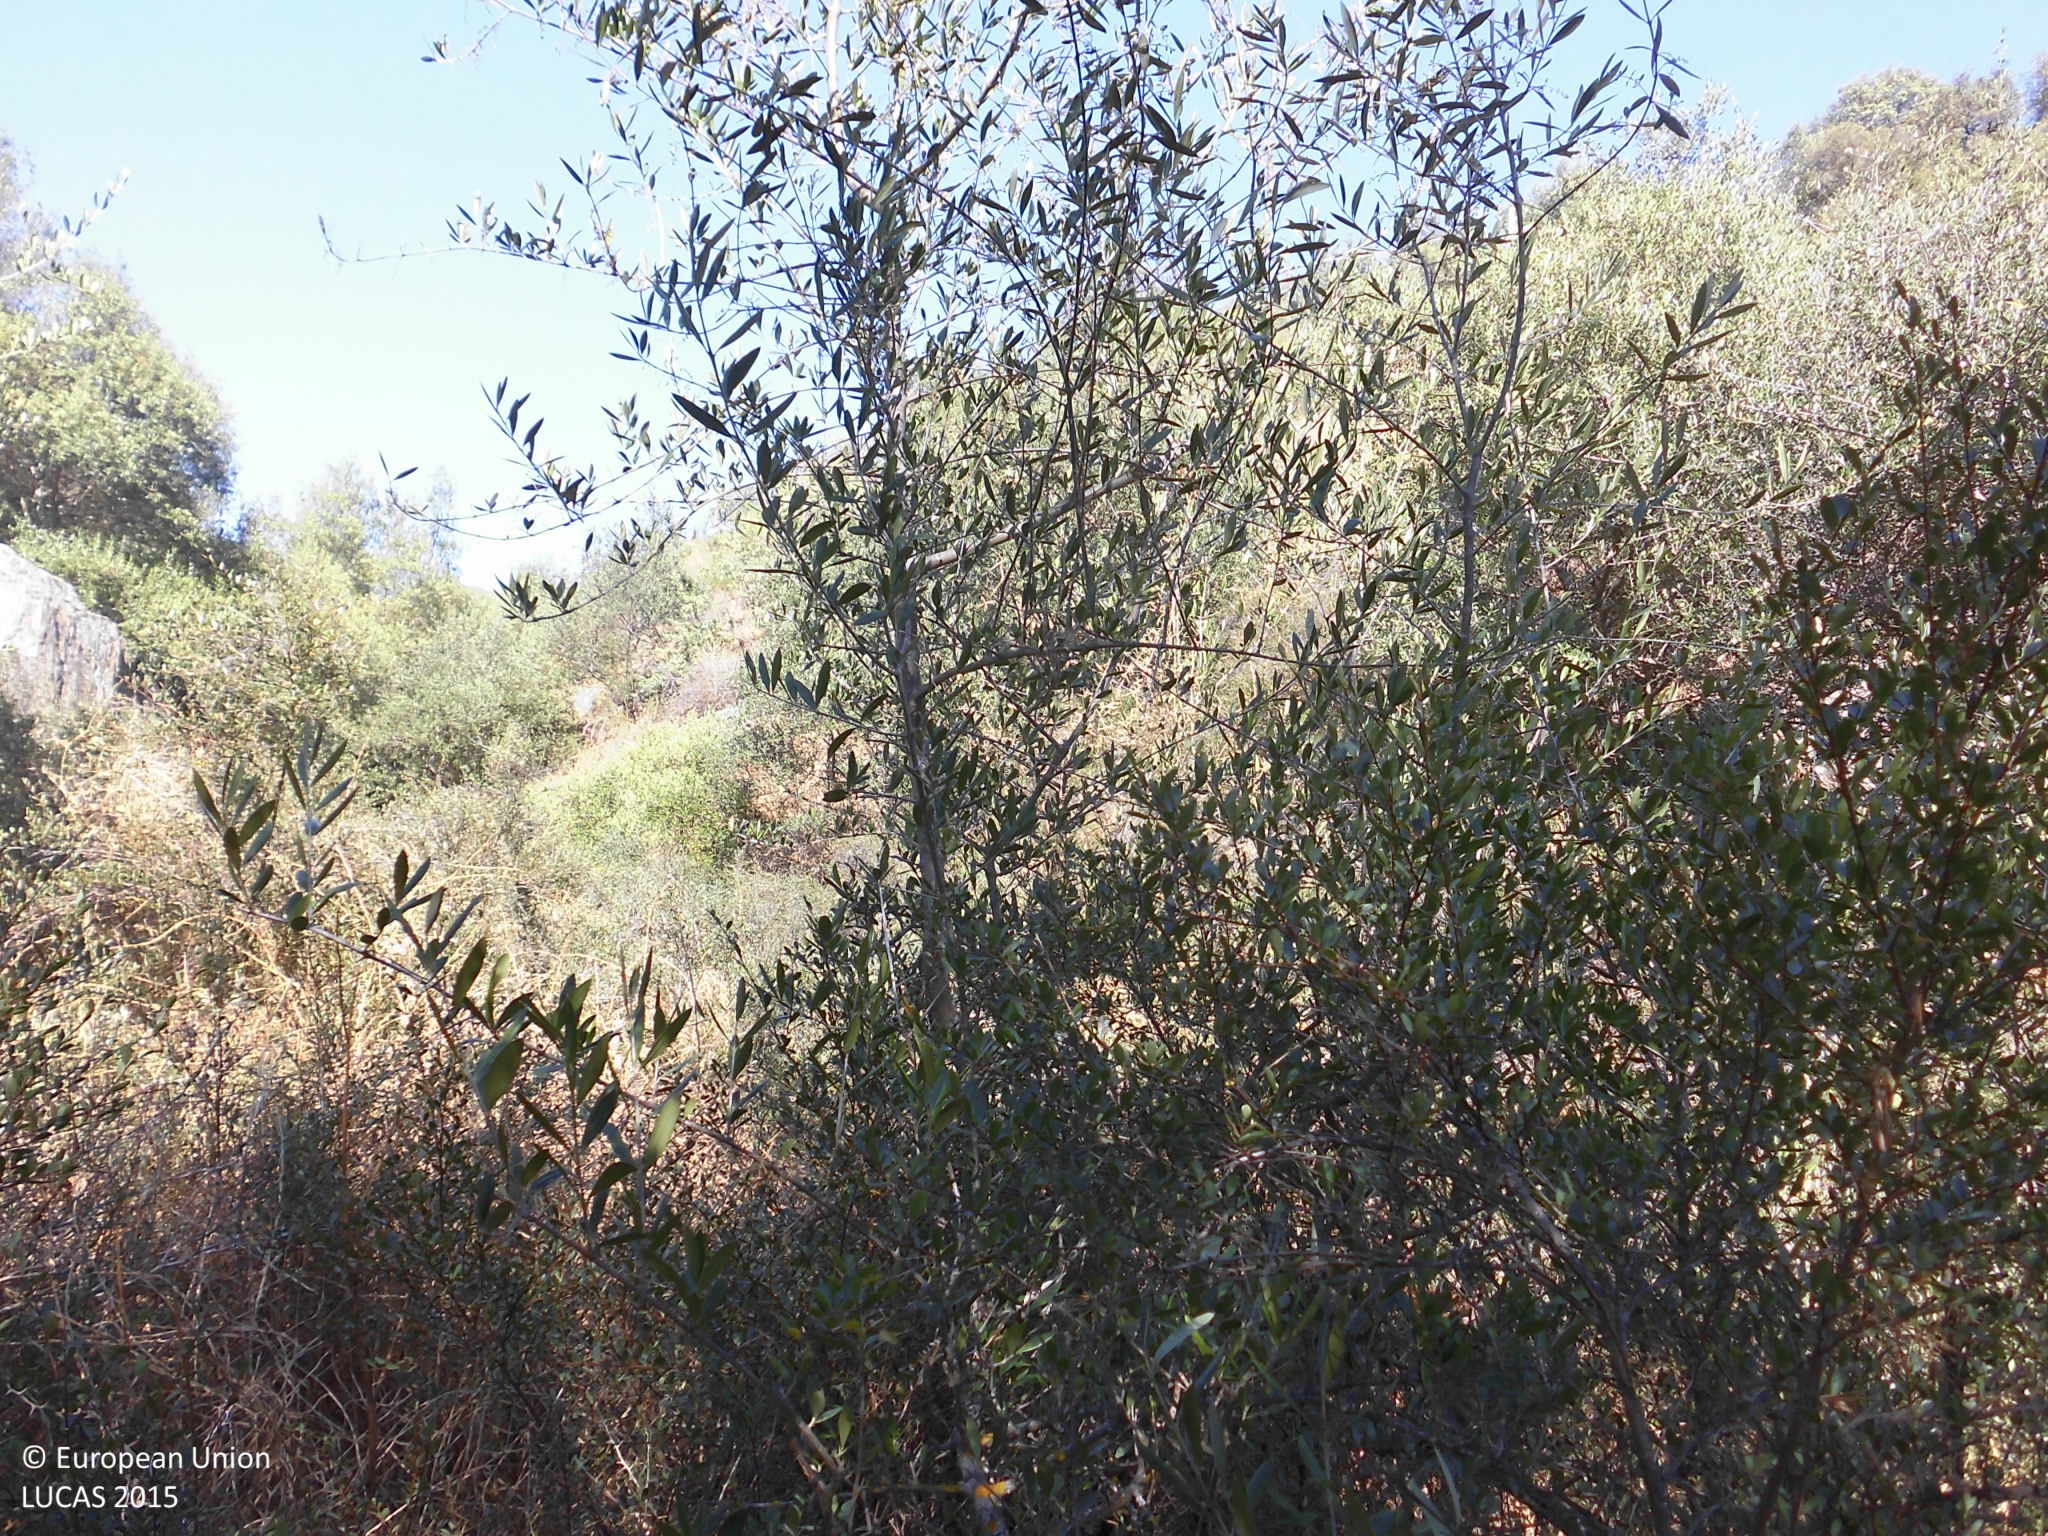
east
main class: Woodland
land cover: Broadleaved woodland
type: thermophilous deciduous forest
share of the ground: 25 - 50 %
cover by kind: broadleaved forest trees 50 %, shrubs 40 %, herbaceous plants 10 %
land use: Semi-natural and natural areas not in use
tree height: > 5 m
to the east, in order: Broadleaved woodland; Shrubland without tree cover; Rivers and streams; Shrubland with sparse tree cover; Rivers and streams; Shrubland without tree cover
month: June
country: ES
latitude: 39.7347
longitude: -6.4444
